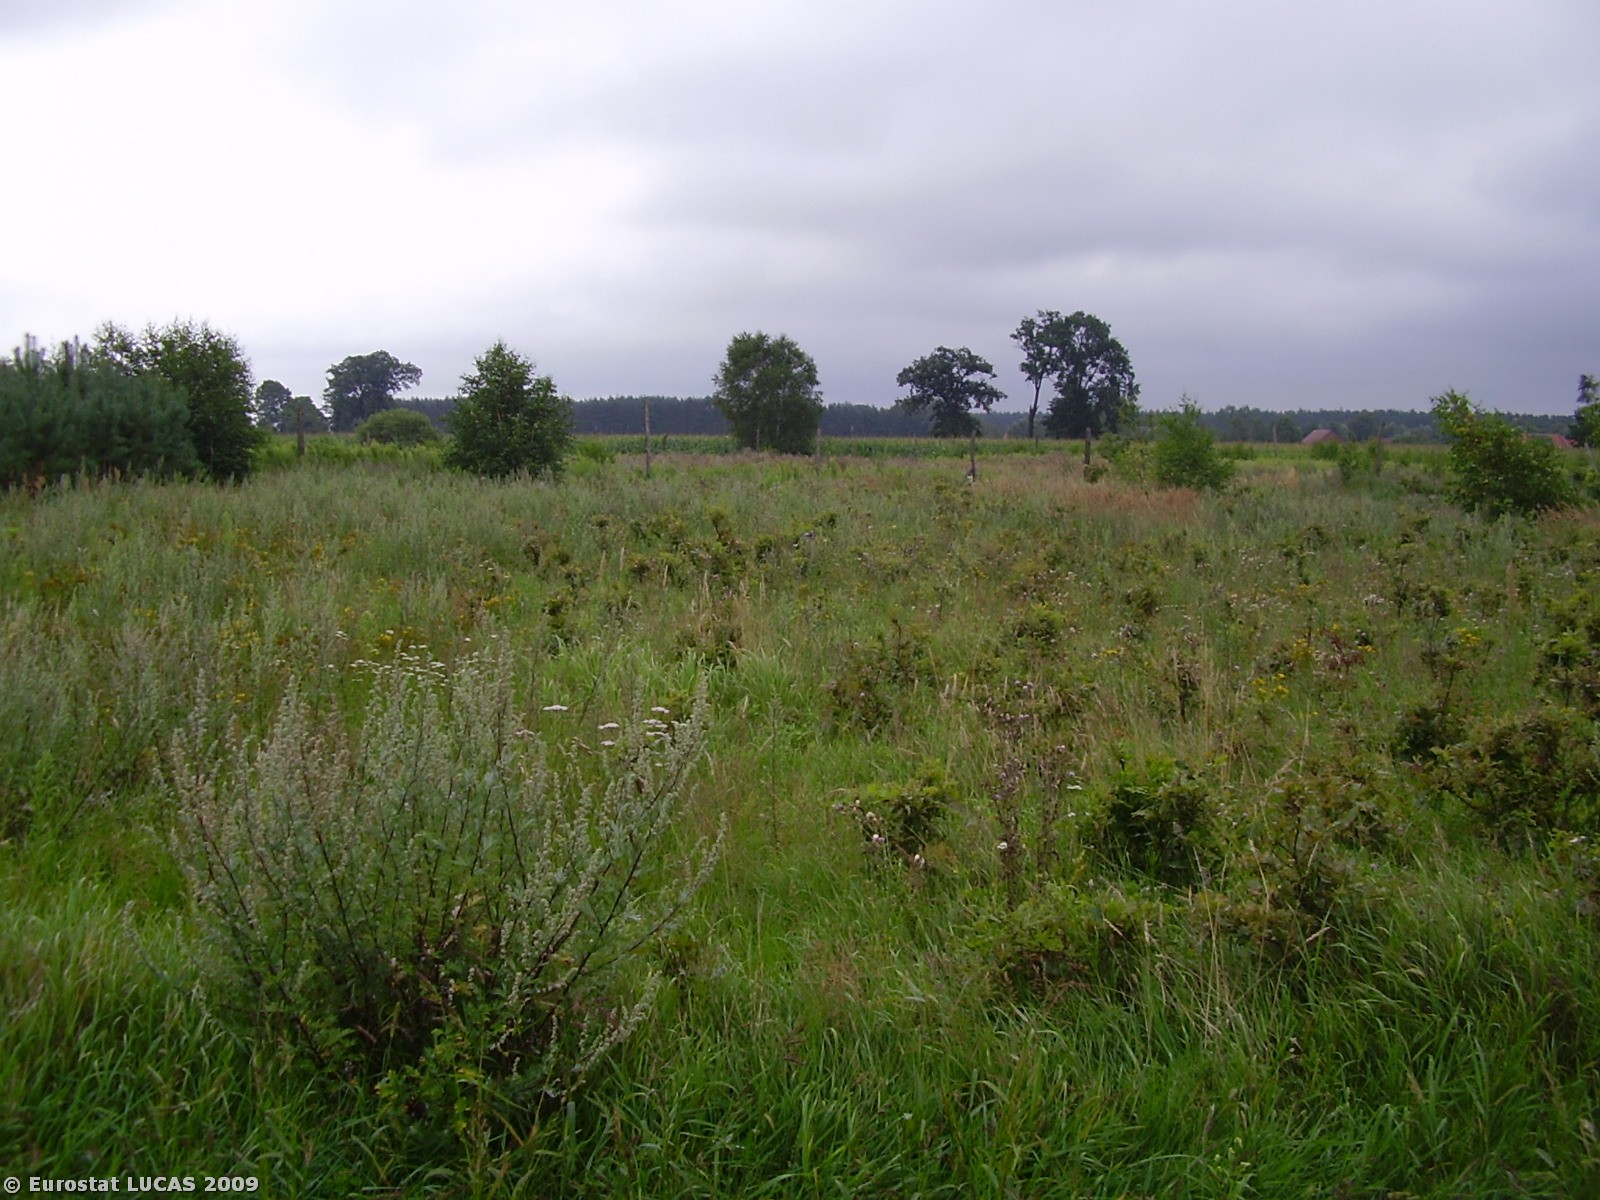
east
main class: Grassland
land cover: Spontaneously vegetated surfaces
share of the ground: > 75 %
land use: Fallow land
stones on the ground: < 10 %
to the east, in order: Spontaneously vegetated surfaces; Tracks; Shrubland with sparse tree cover; Tracks; Fences; Spontaneously vegetated surfaces; Fences; Maize
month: April
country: PL
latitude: 51.5314
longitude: 16.8278
